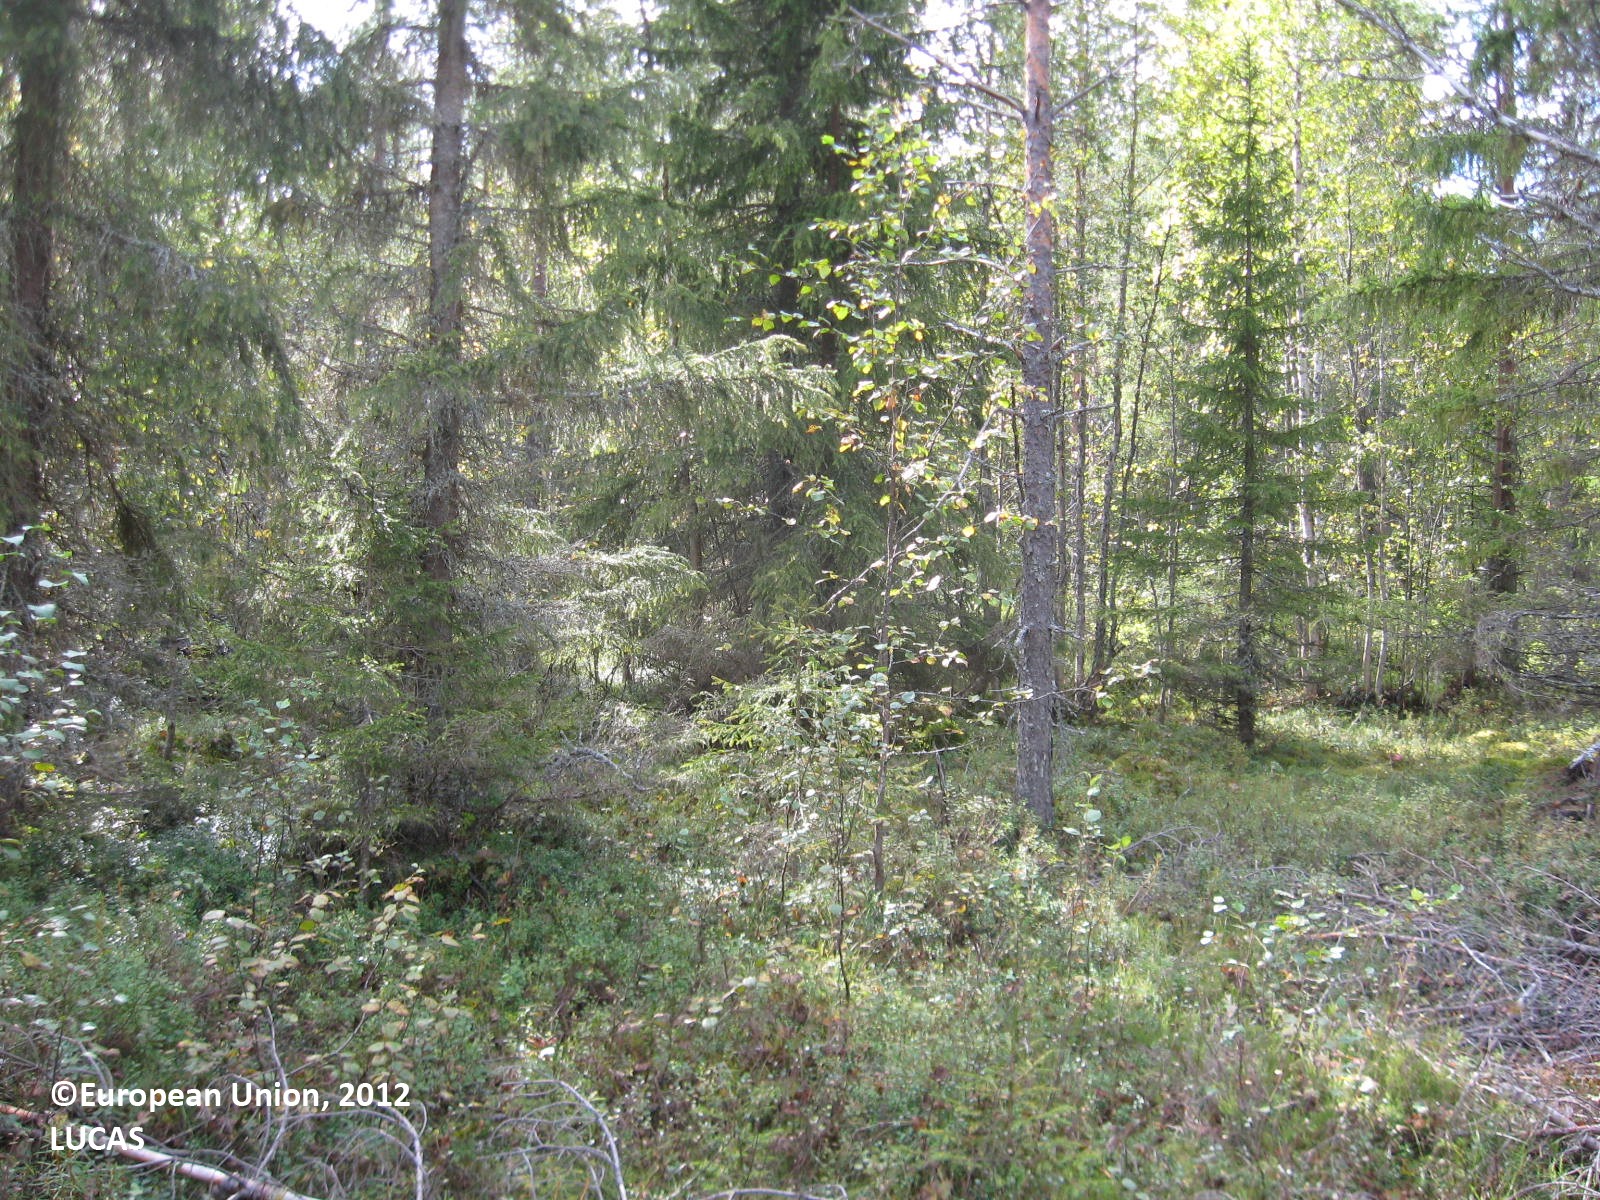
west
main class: Woodland
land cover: Other coniferous woodland
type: boreal forest
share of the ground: > 75 %
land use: Forestry
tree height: > 5 m
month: August
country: FI
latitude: 63.8155
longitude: 29.1186
